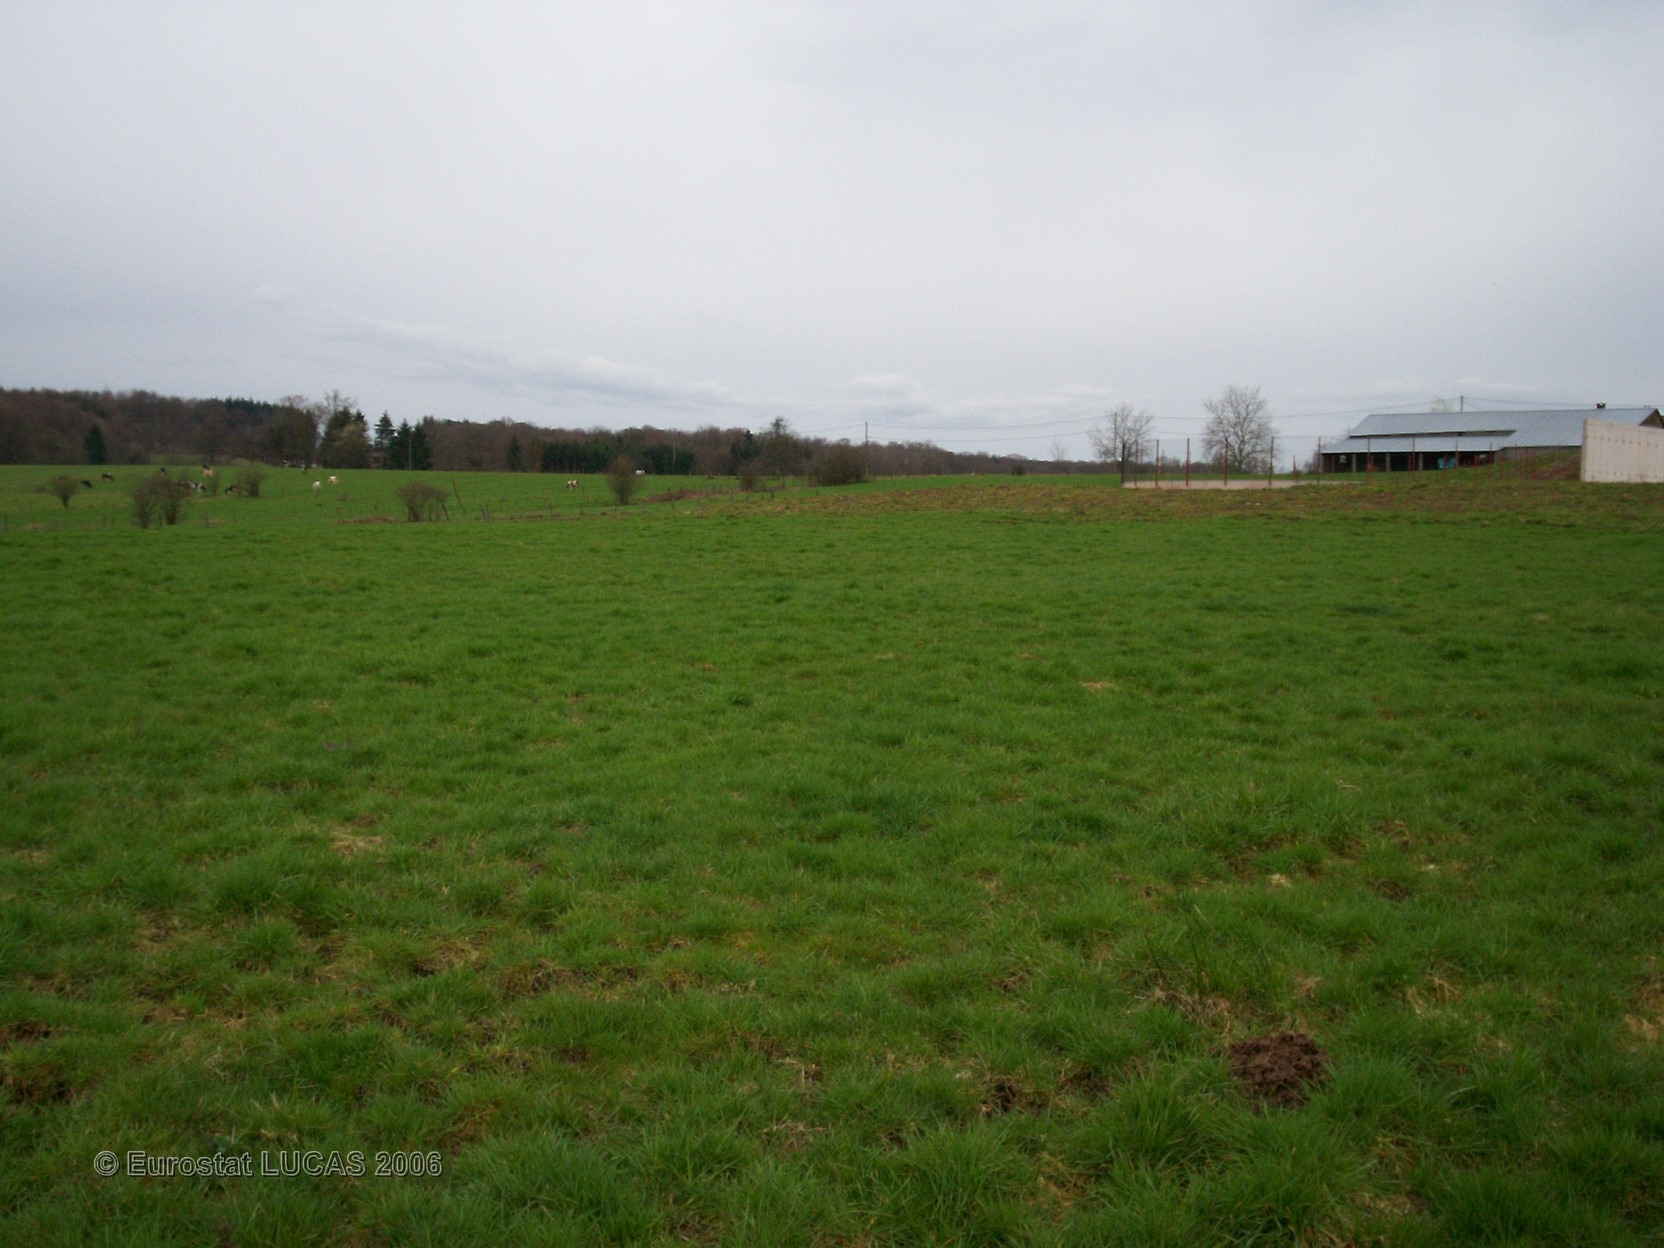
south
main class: Grassland
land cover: Grassland without tree/shrub cover
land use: Agriculture (excluding fallow land and kitchen gardens)
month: April
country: FR
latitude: 47.9621
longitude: 6.2643
